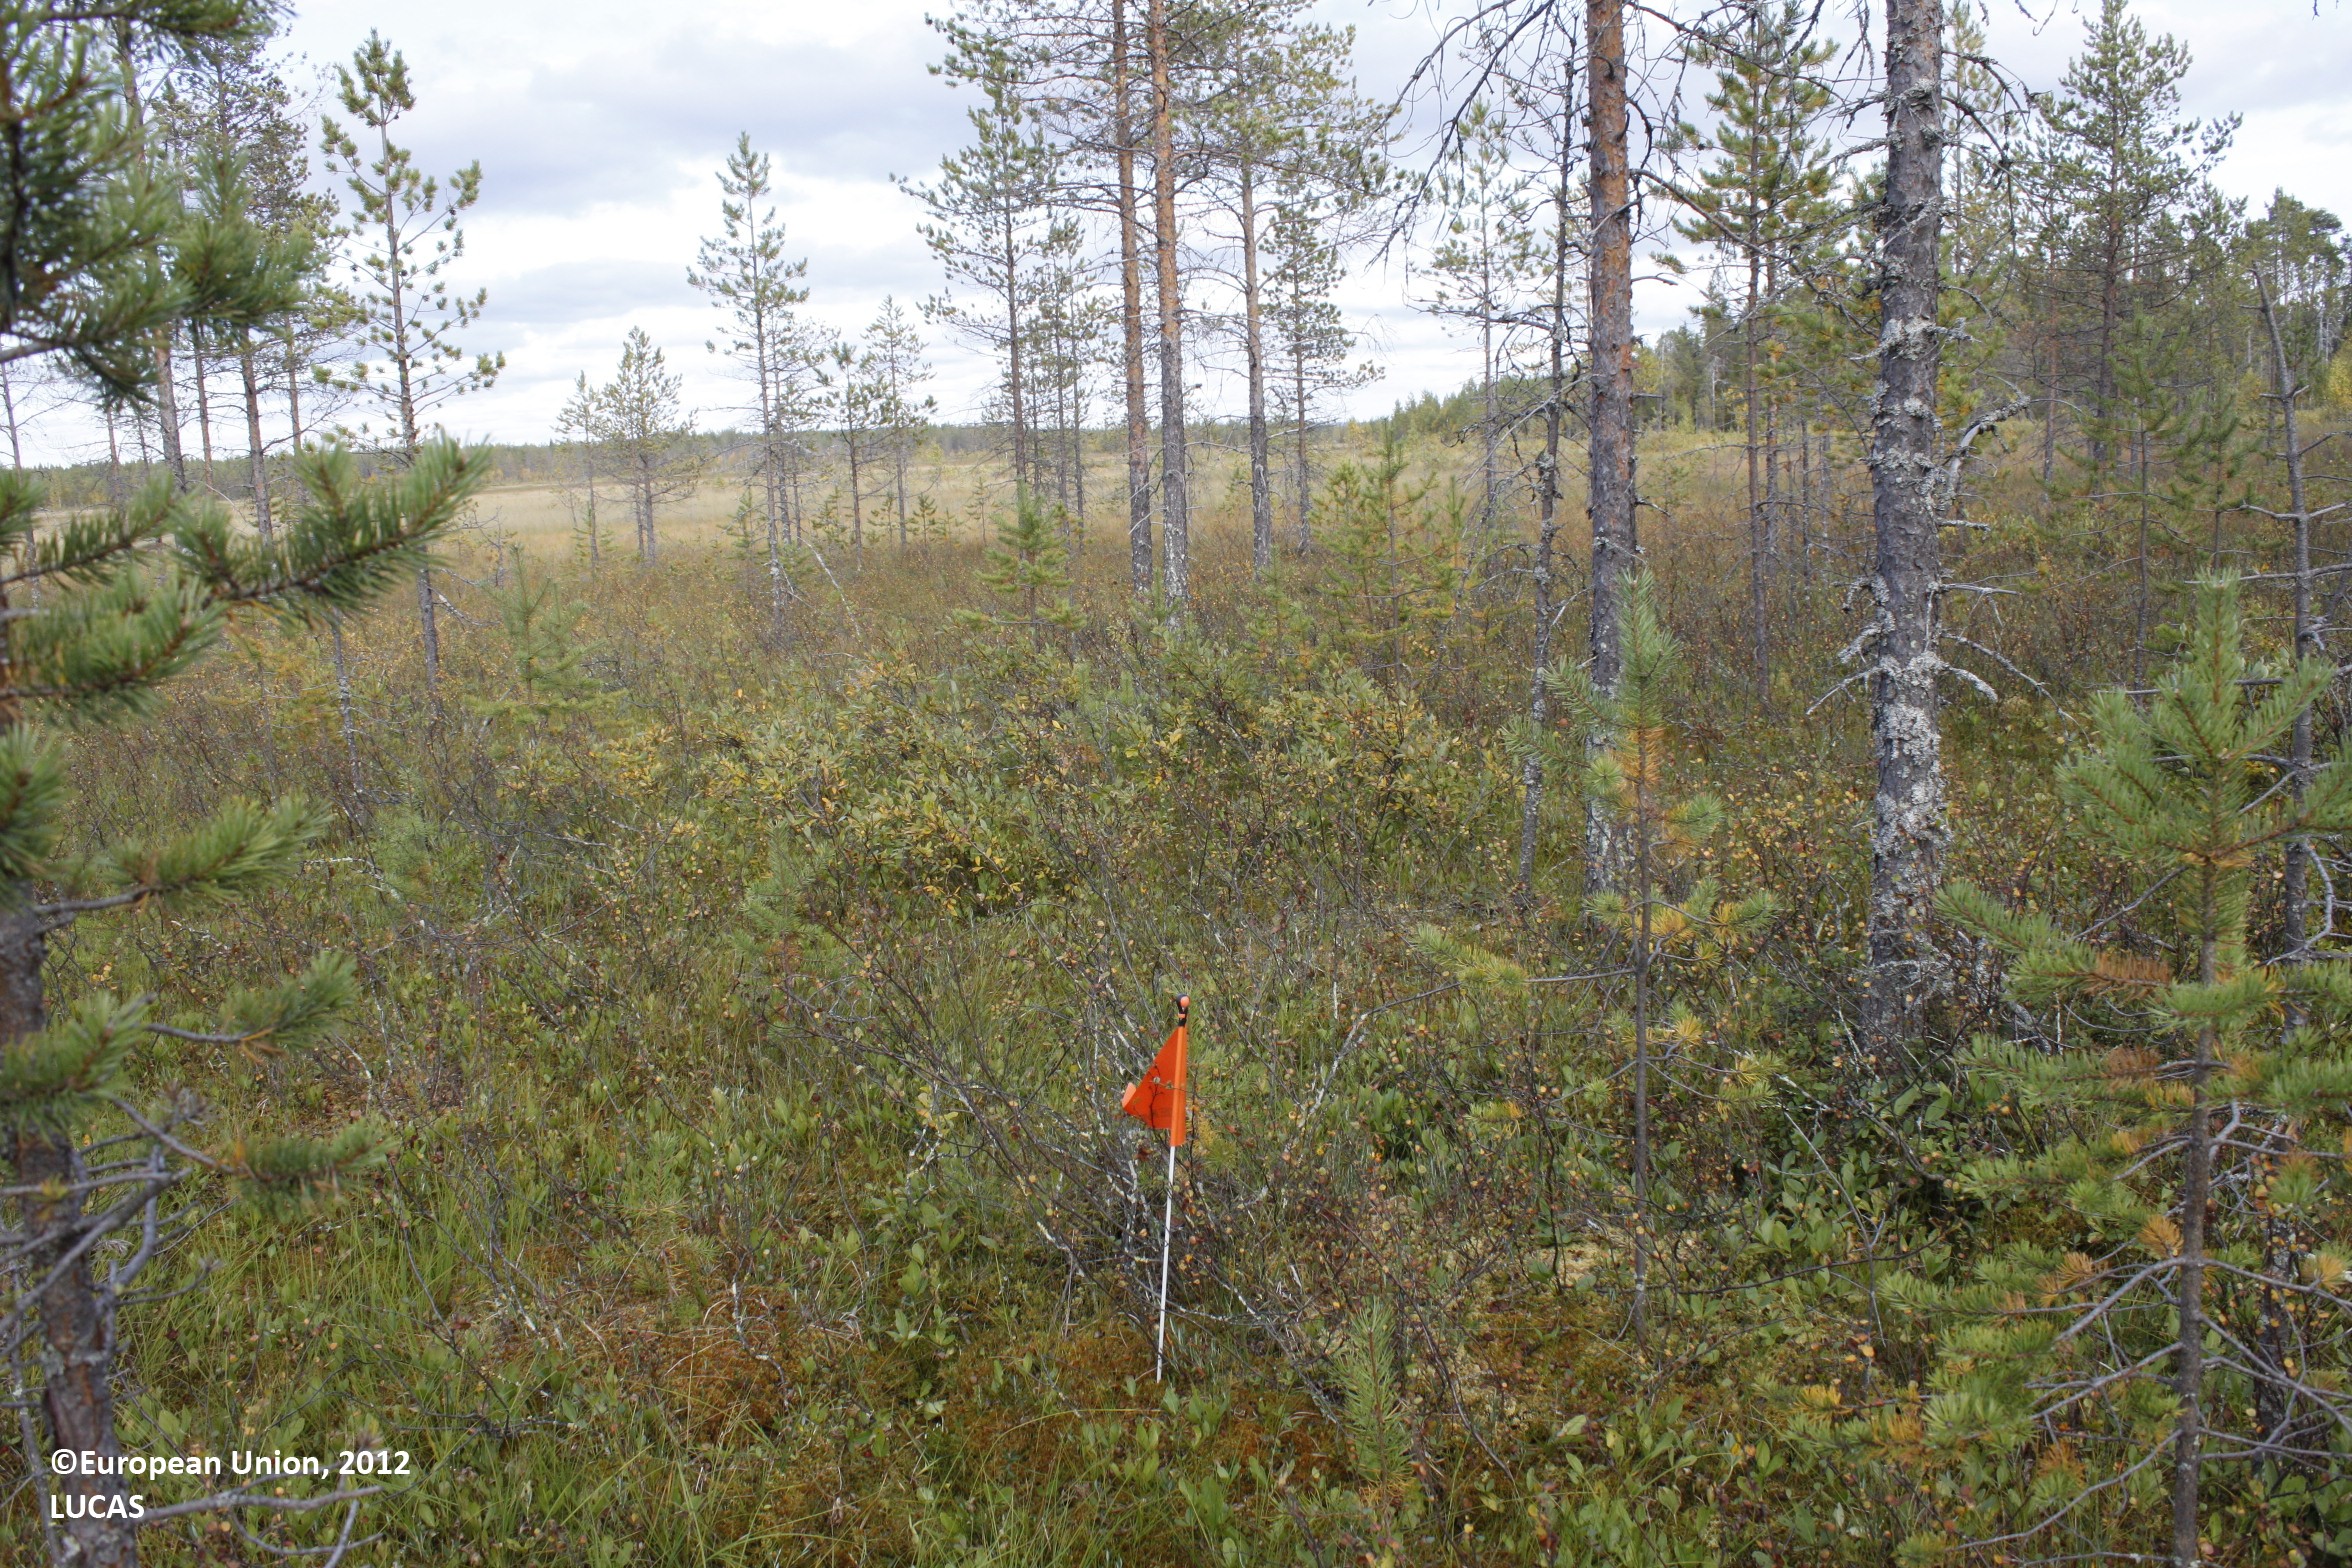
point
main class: Woodland
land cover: Pine dominated coniferous woodland
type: mire and swamp forests
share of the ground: 25 - 50 %
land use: Semi-natural and natural areas not in use
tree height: > 5 m
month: September
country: FI
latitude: 65.4144
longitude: 27.2479
